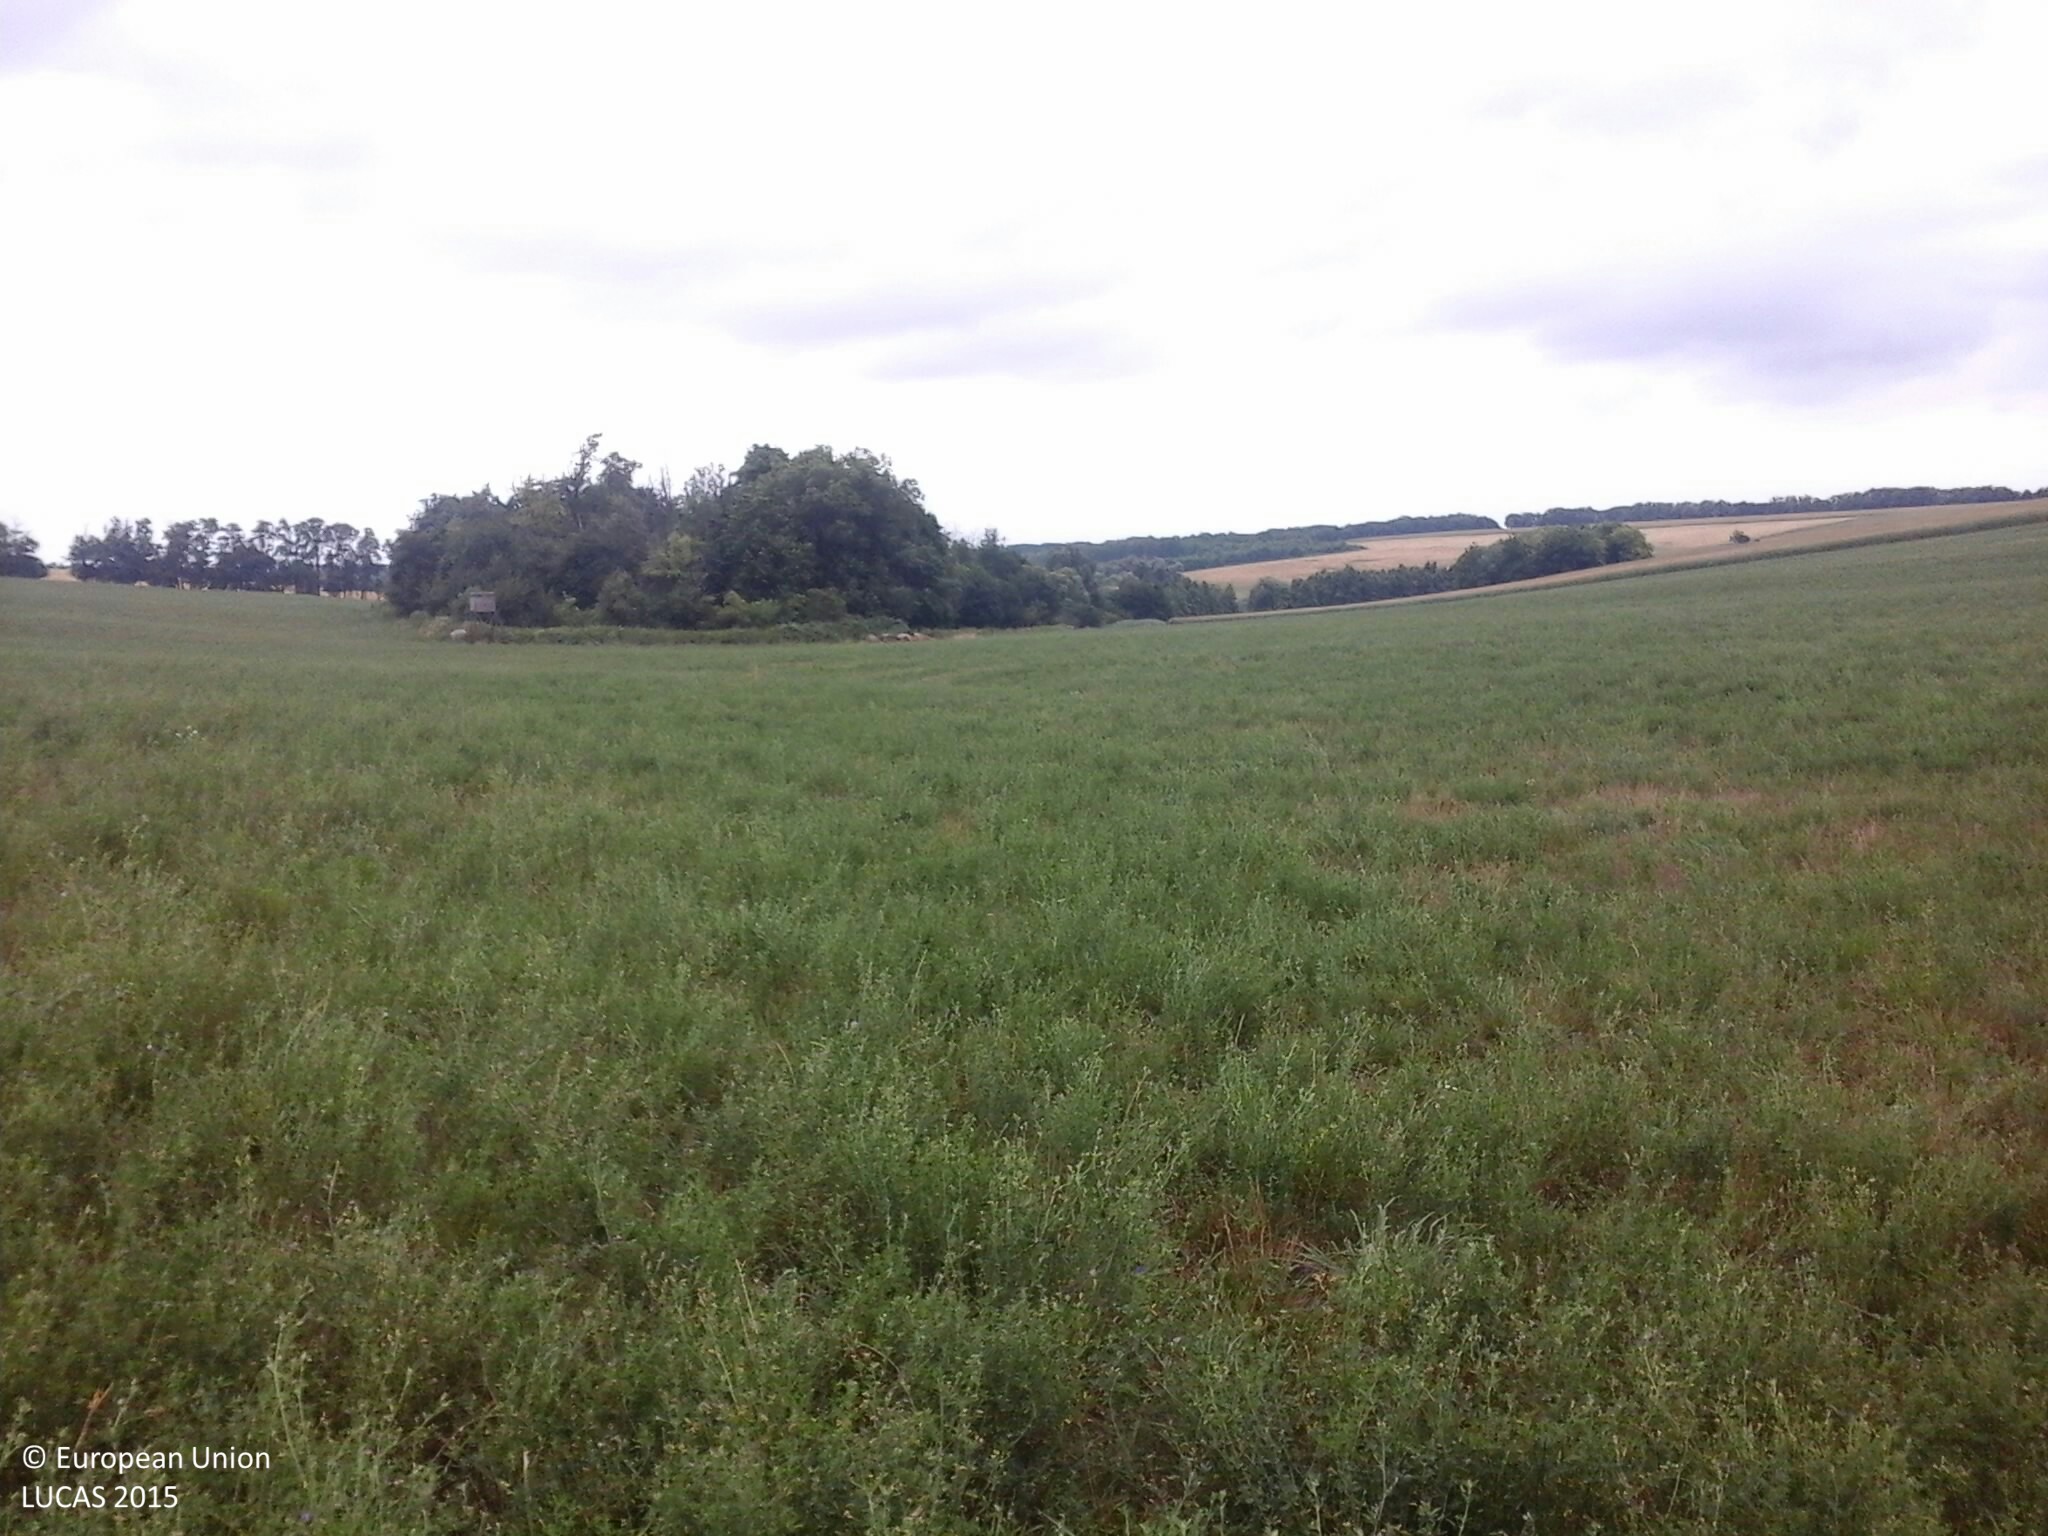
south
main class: Cropland
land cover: Lucerne
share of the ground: > 75 %
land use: Agriculture (excluding fallow land and kitchen gardens)
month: July
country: HU
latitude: 46.7641
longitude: 17.9033
